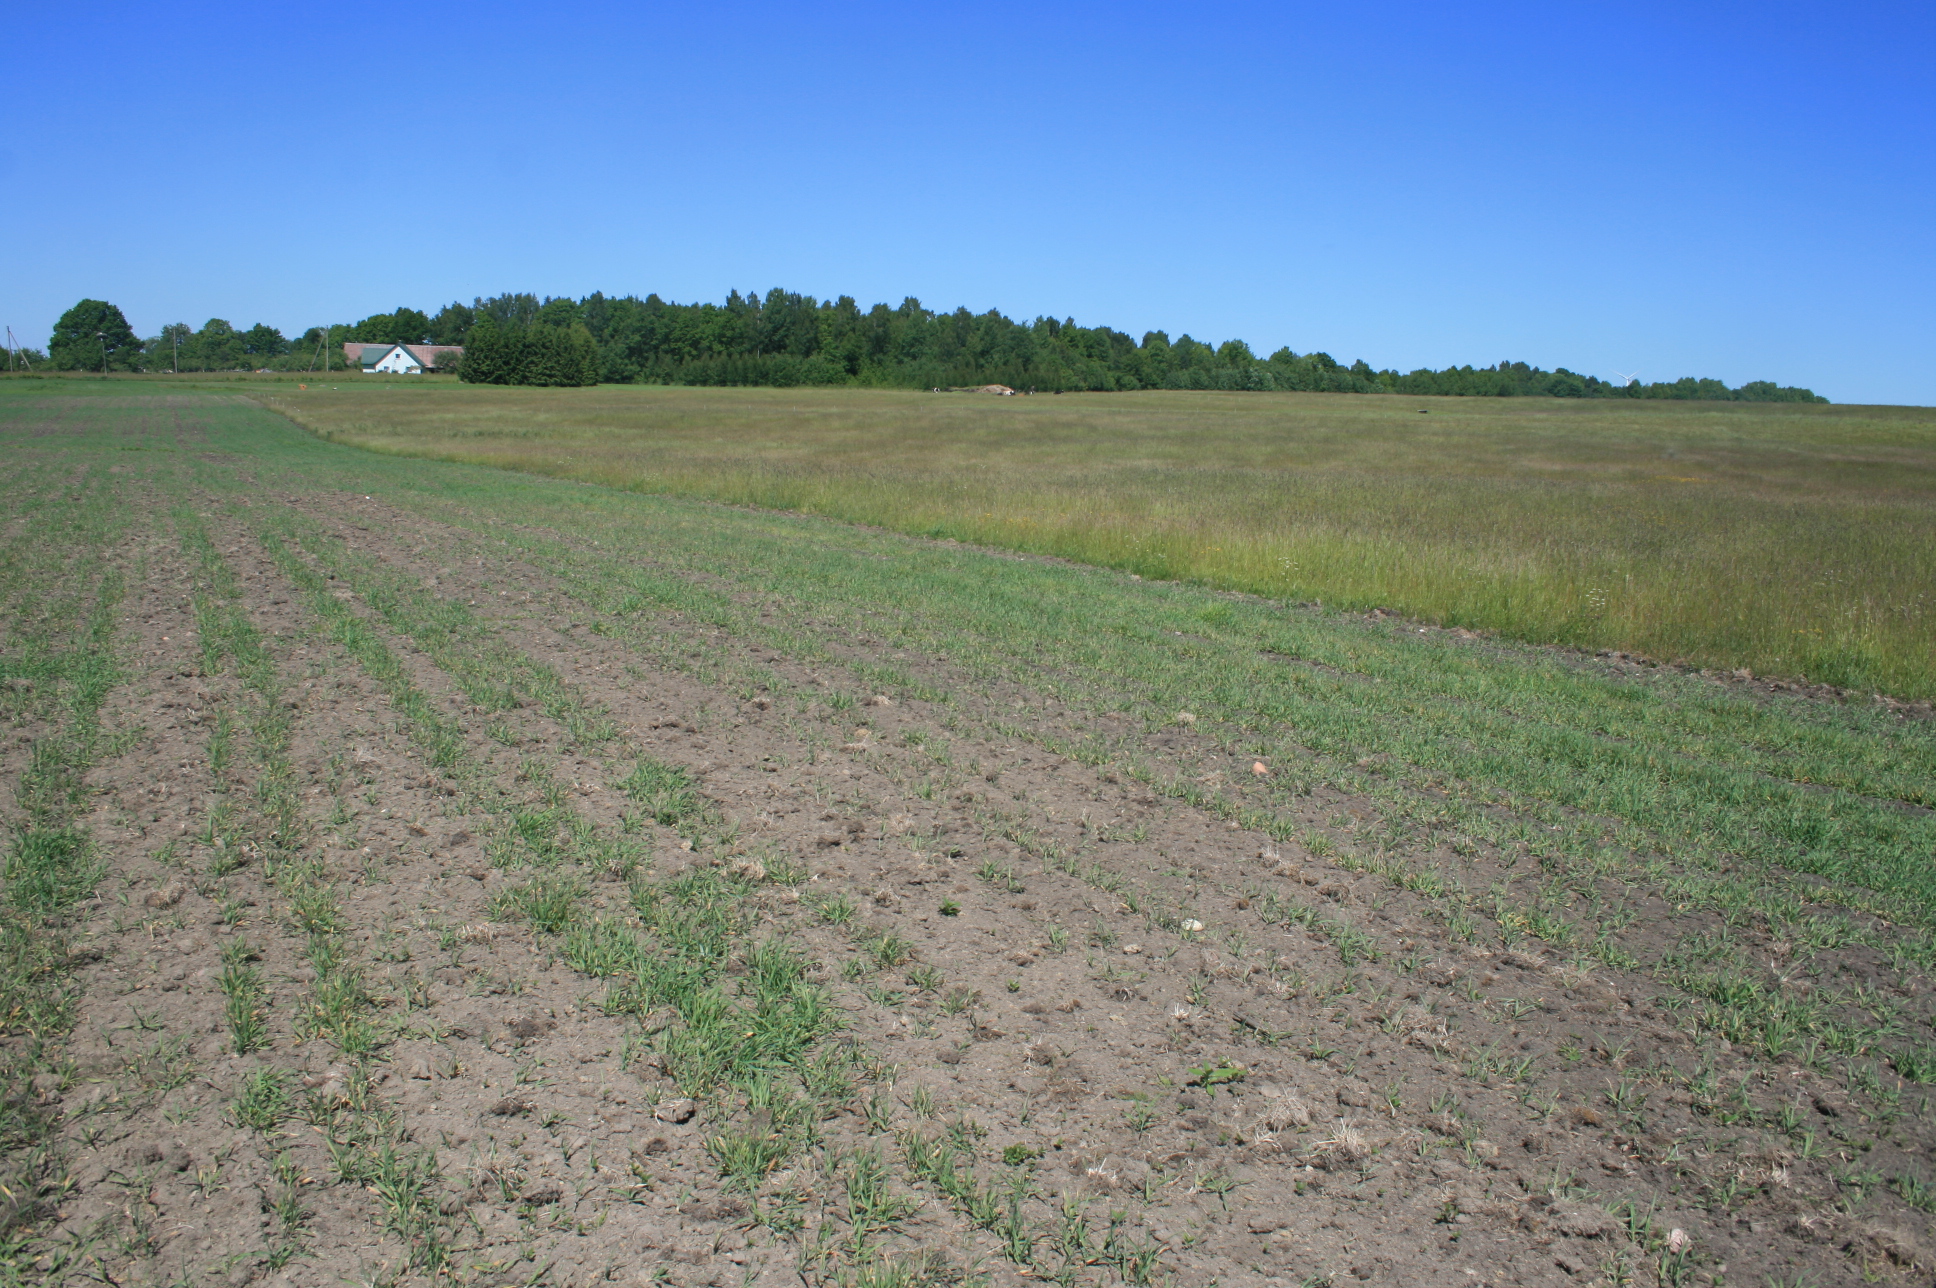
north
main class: Cropland
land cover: Barley
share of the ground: 25 - 50 %
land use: Agriculture (excluding fallow land and kitchen gardens)
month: June
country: LT
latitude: 55.5325
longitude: 22.1761
